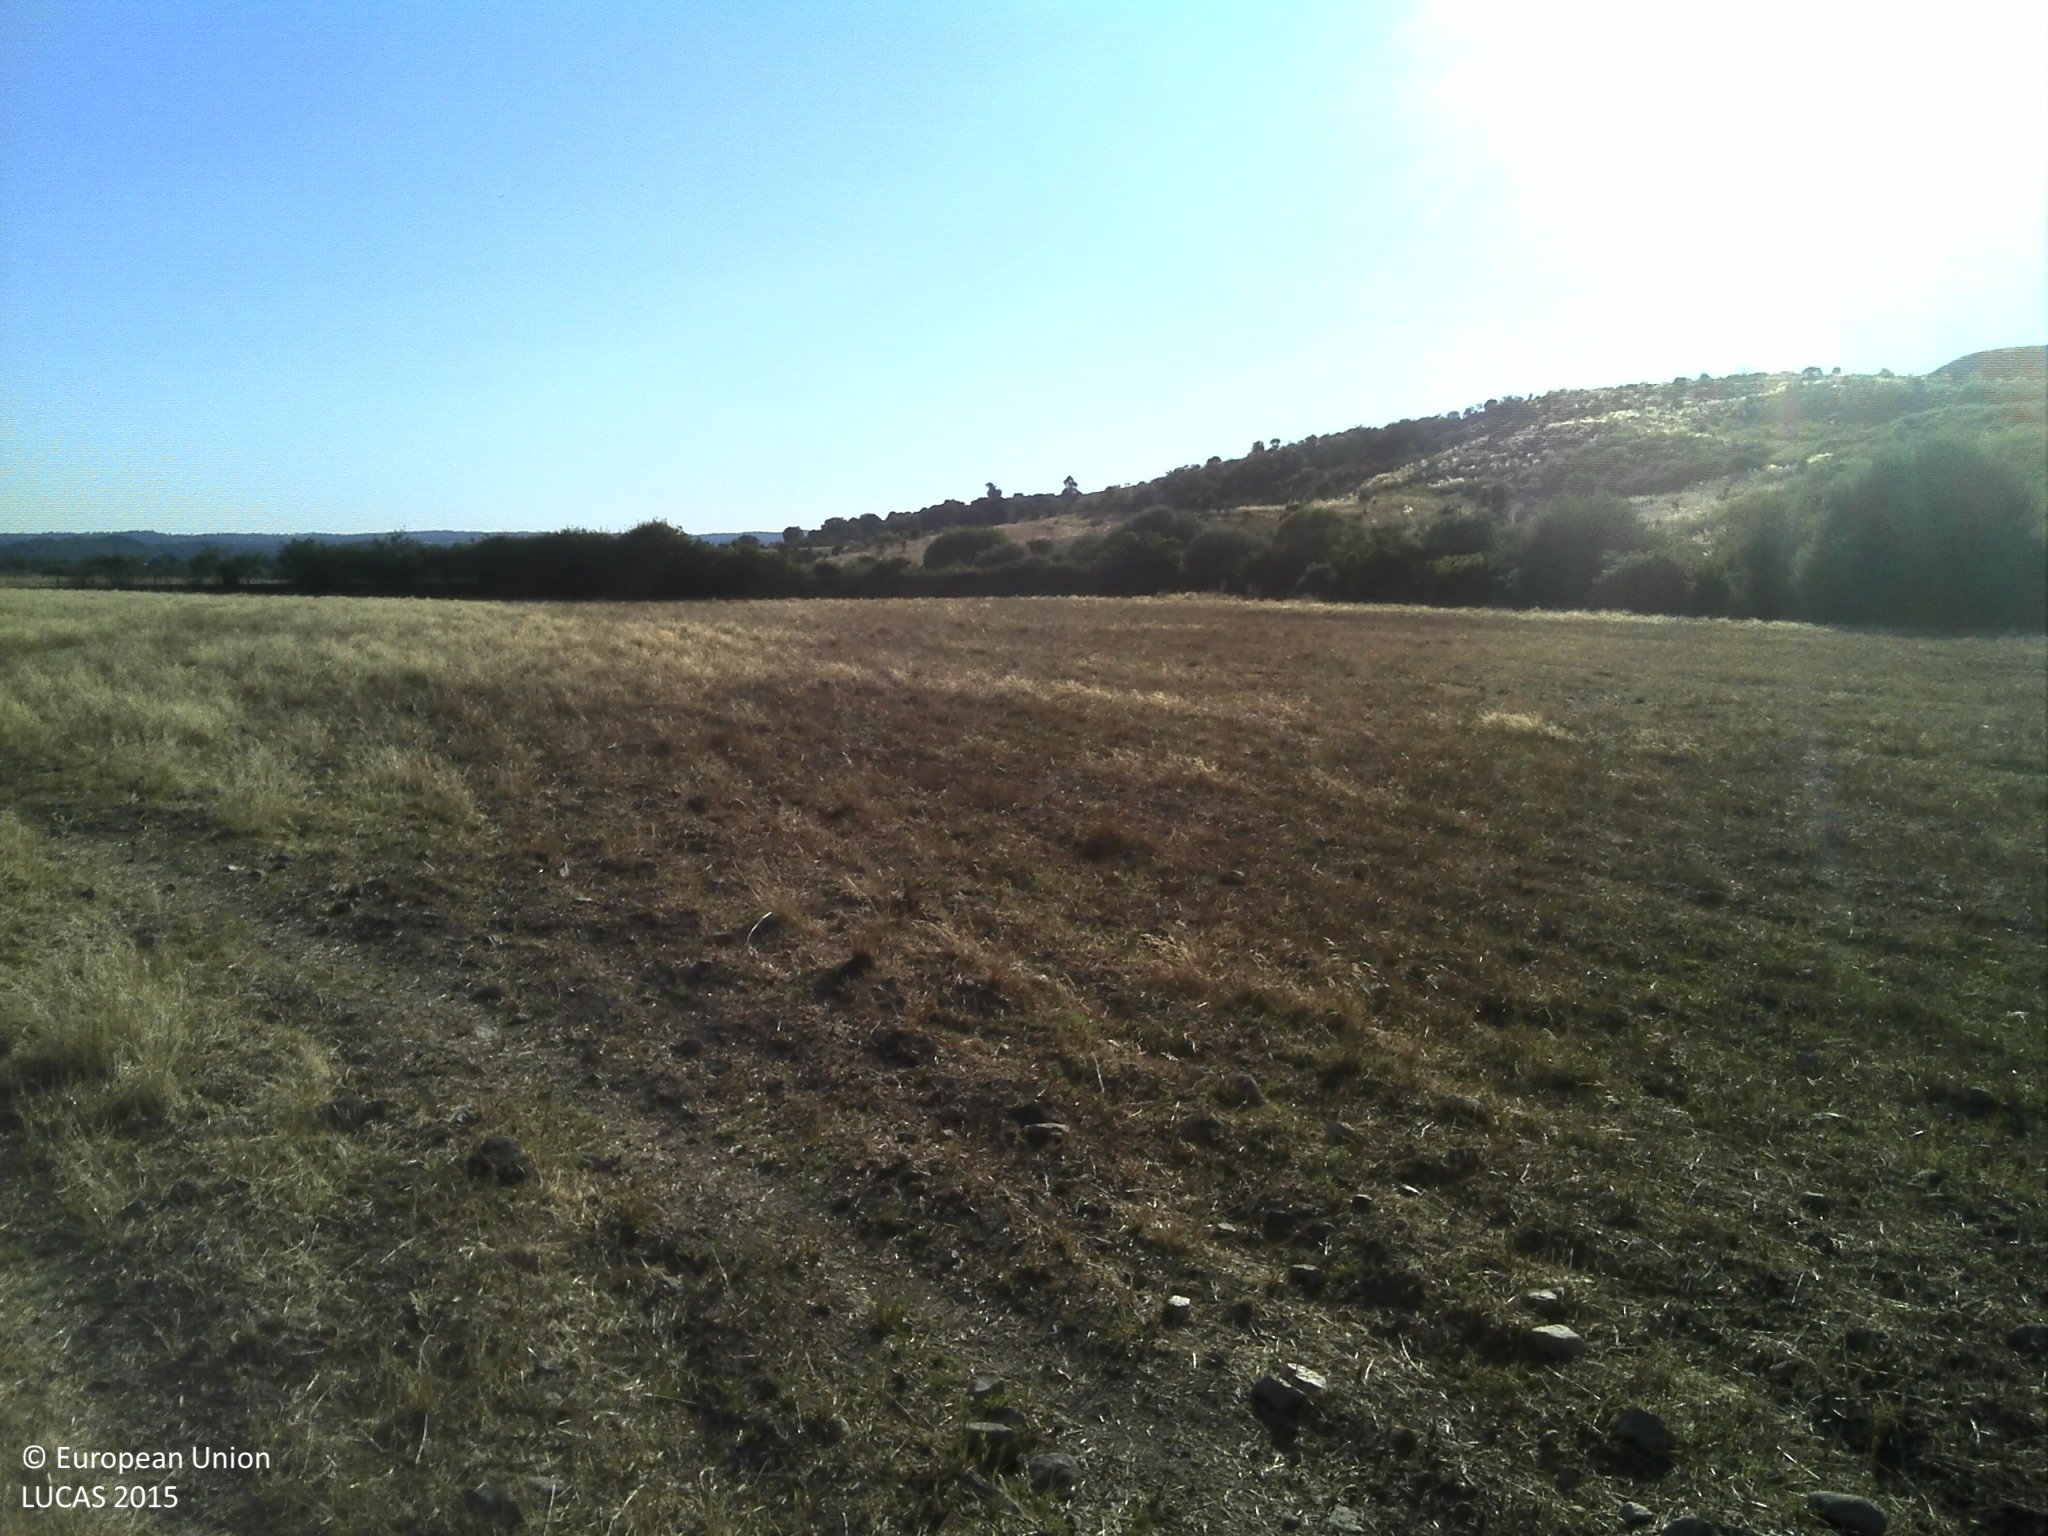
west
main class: Grassland
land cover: Grassland without tree/shrub cover
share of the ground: 50 - 75 %
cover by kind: herbaceous plants 60 %, unconsolidated bare surface 35 %
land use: Agriculture (excluding fallow land and kitchen gardens)
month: June
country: PT
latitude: 39.9901
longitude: -7.3017
